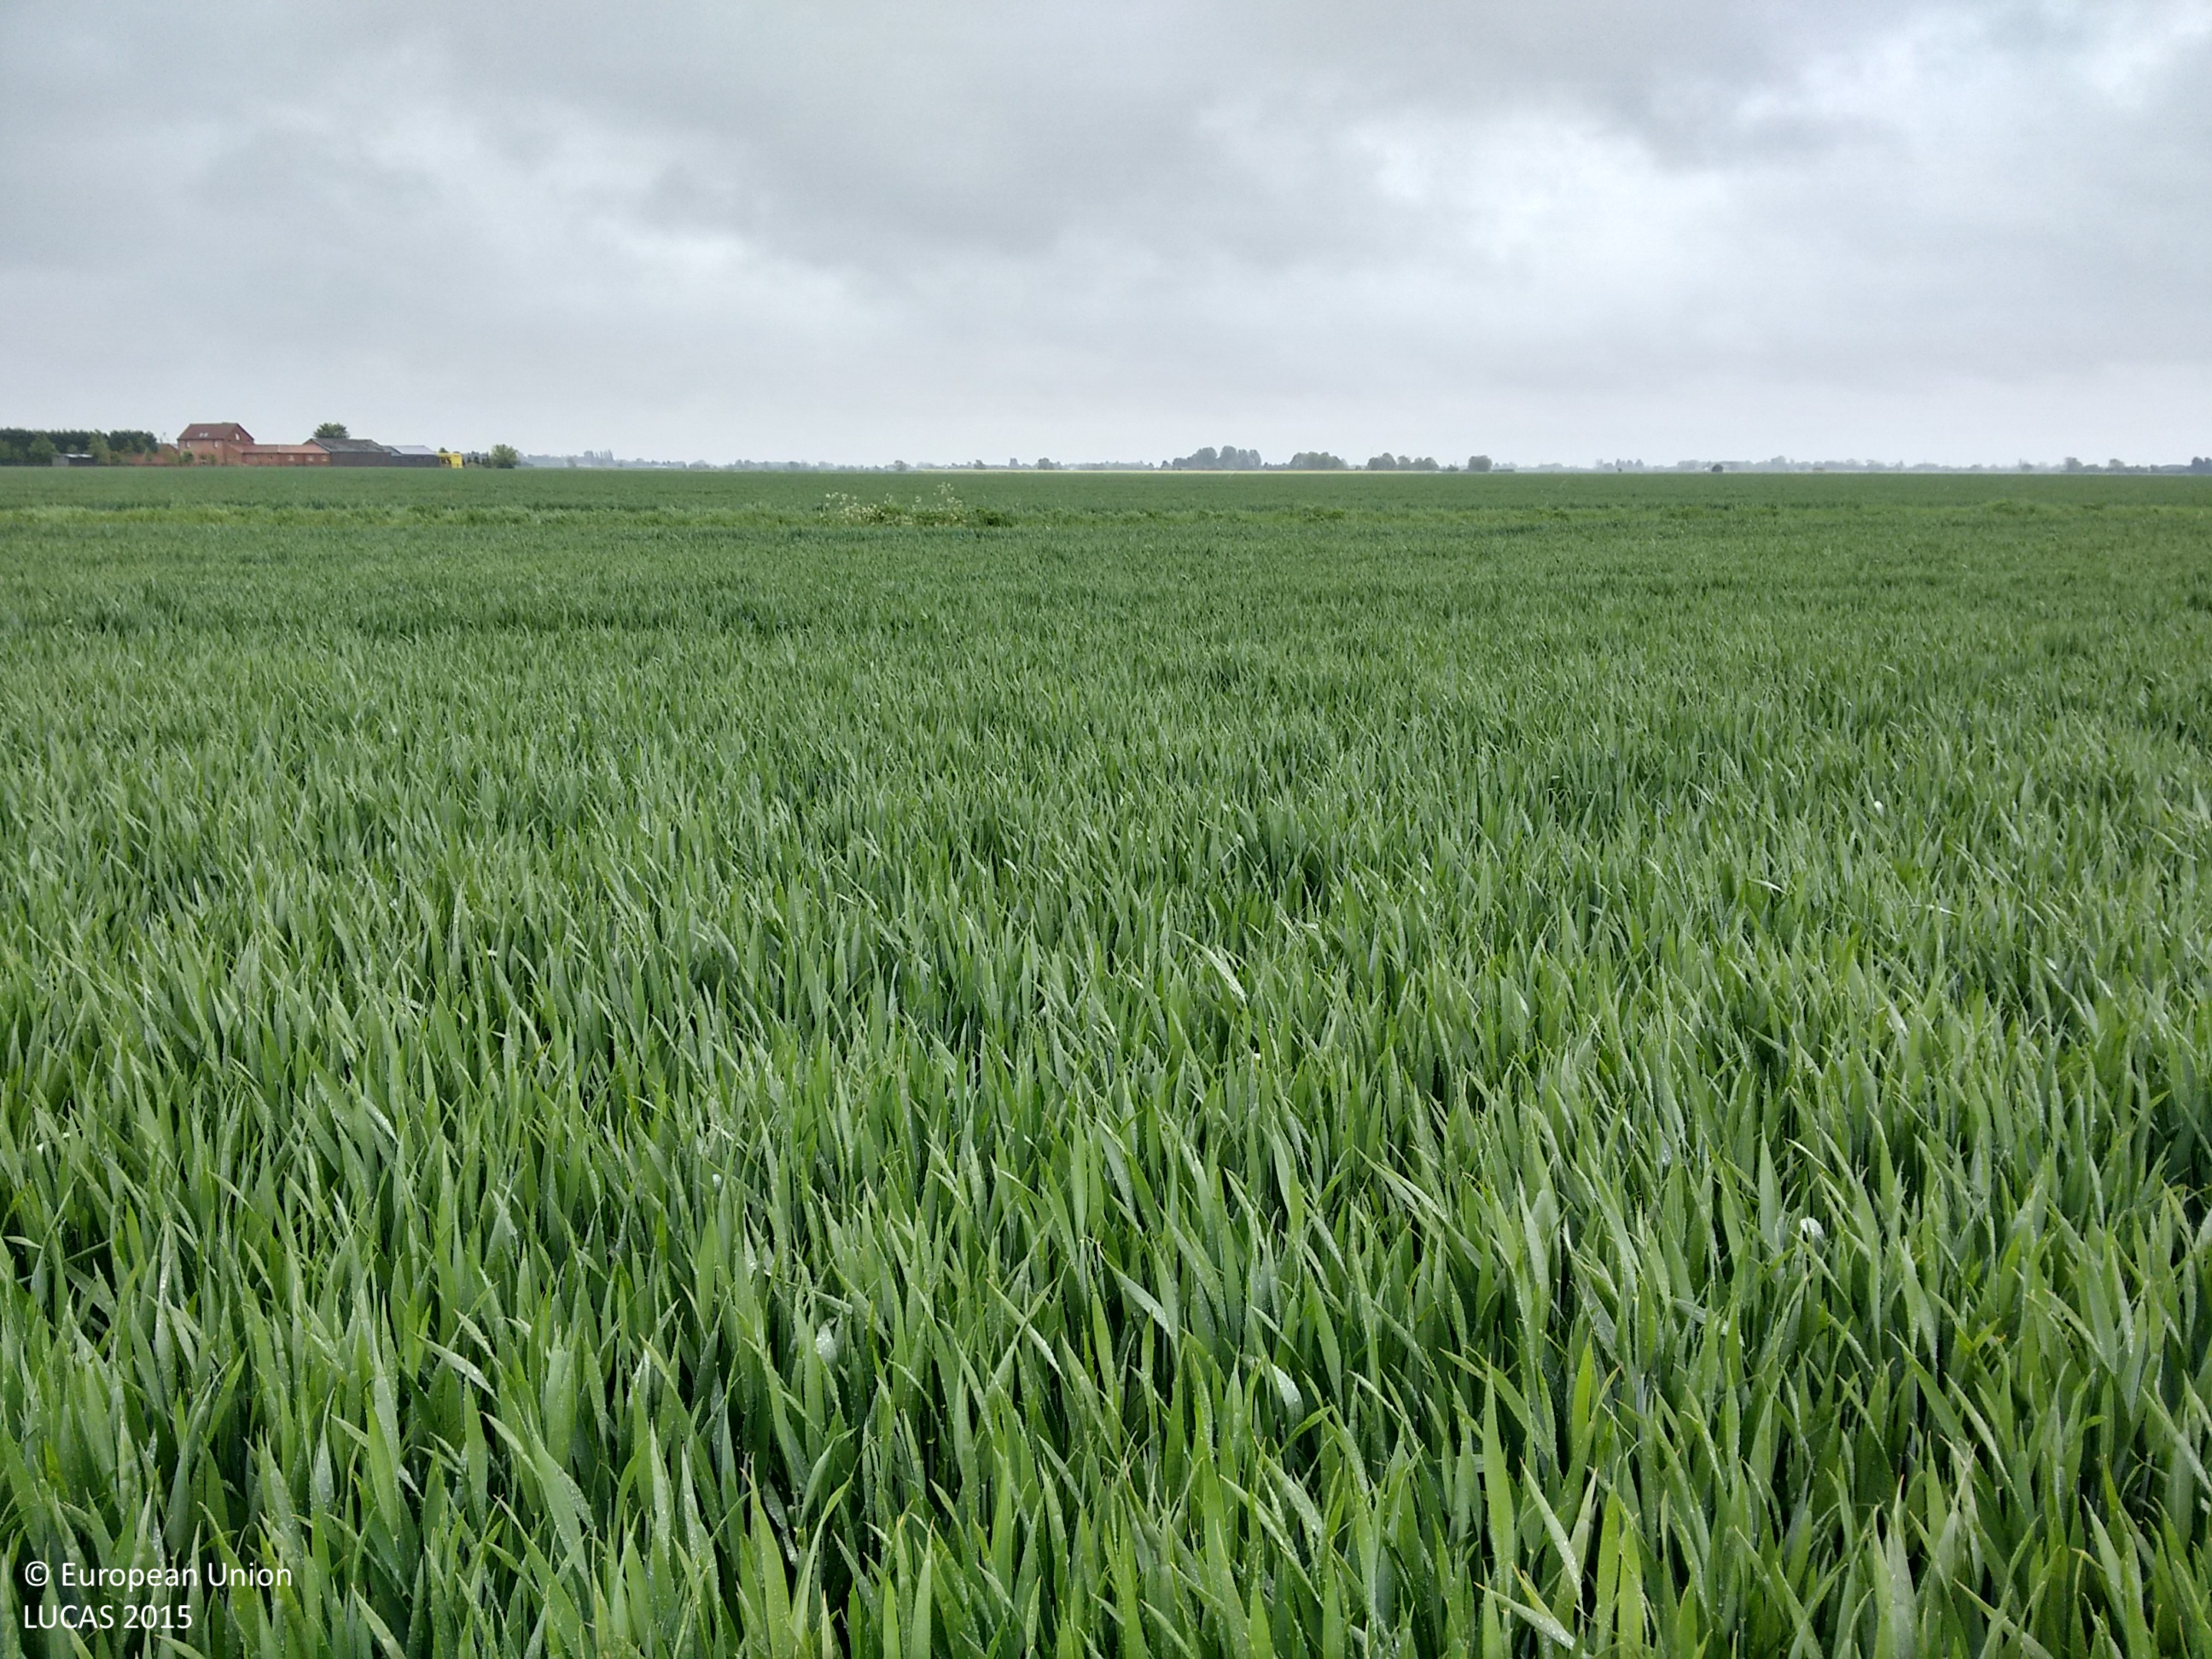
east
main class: Cropland
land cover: Common wheat
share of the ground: > 75 %
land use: Agriculture (excluding fallow land and kitchen gardens)
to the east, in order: Common wheat; Grass margins; Ditches and canals; Grass margins; Barley
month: May
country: GB
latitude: 52.8859
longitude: -0.1245
